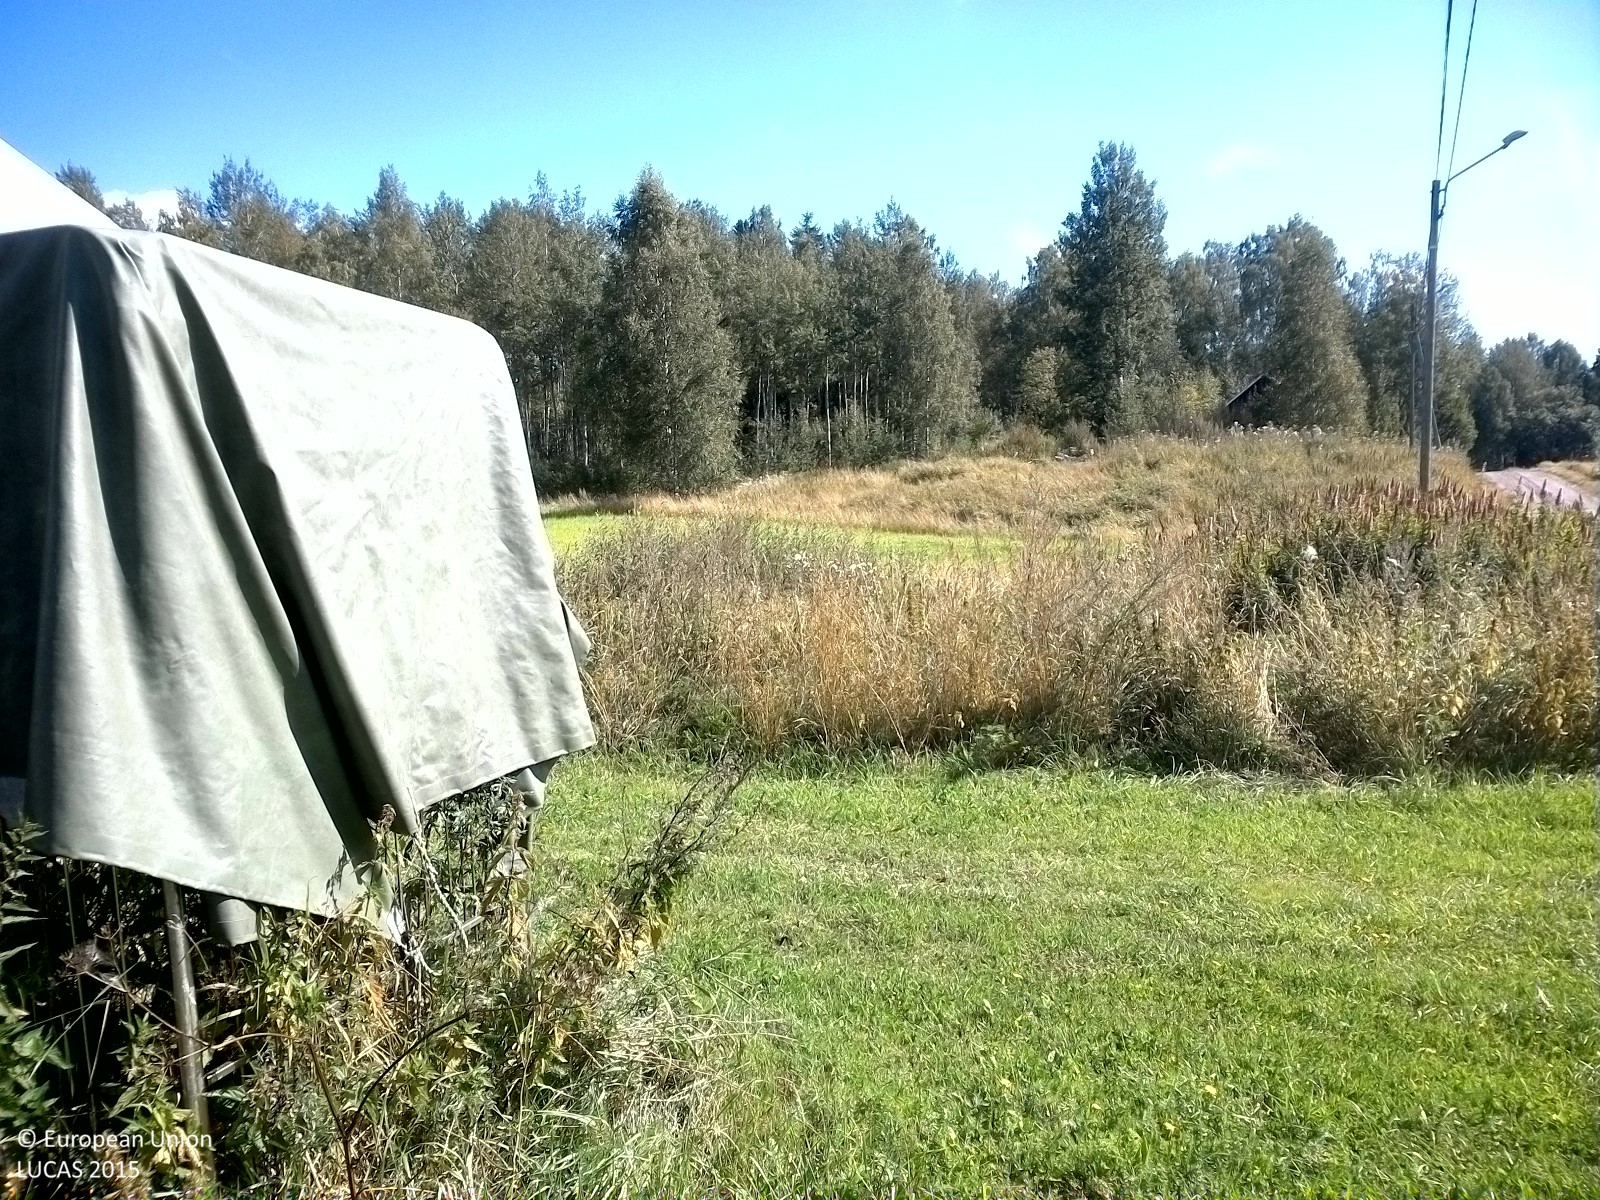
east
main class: Grassland
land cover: Spontaneously vegetated surfaces
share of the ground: > 75 %
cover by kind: herbaceous plants 100 %
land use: Residential
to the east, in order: Spontaneously vegetated surfaces; Ditches and canals; Temporary grasslands; Ditches and canals; Spontaneously vegetated surfaces; Broadleaved woodland; Spruce dominated mixed woodland; Temporary grasslands
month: August
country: SE
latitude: 59.4702
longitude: 15.2327
